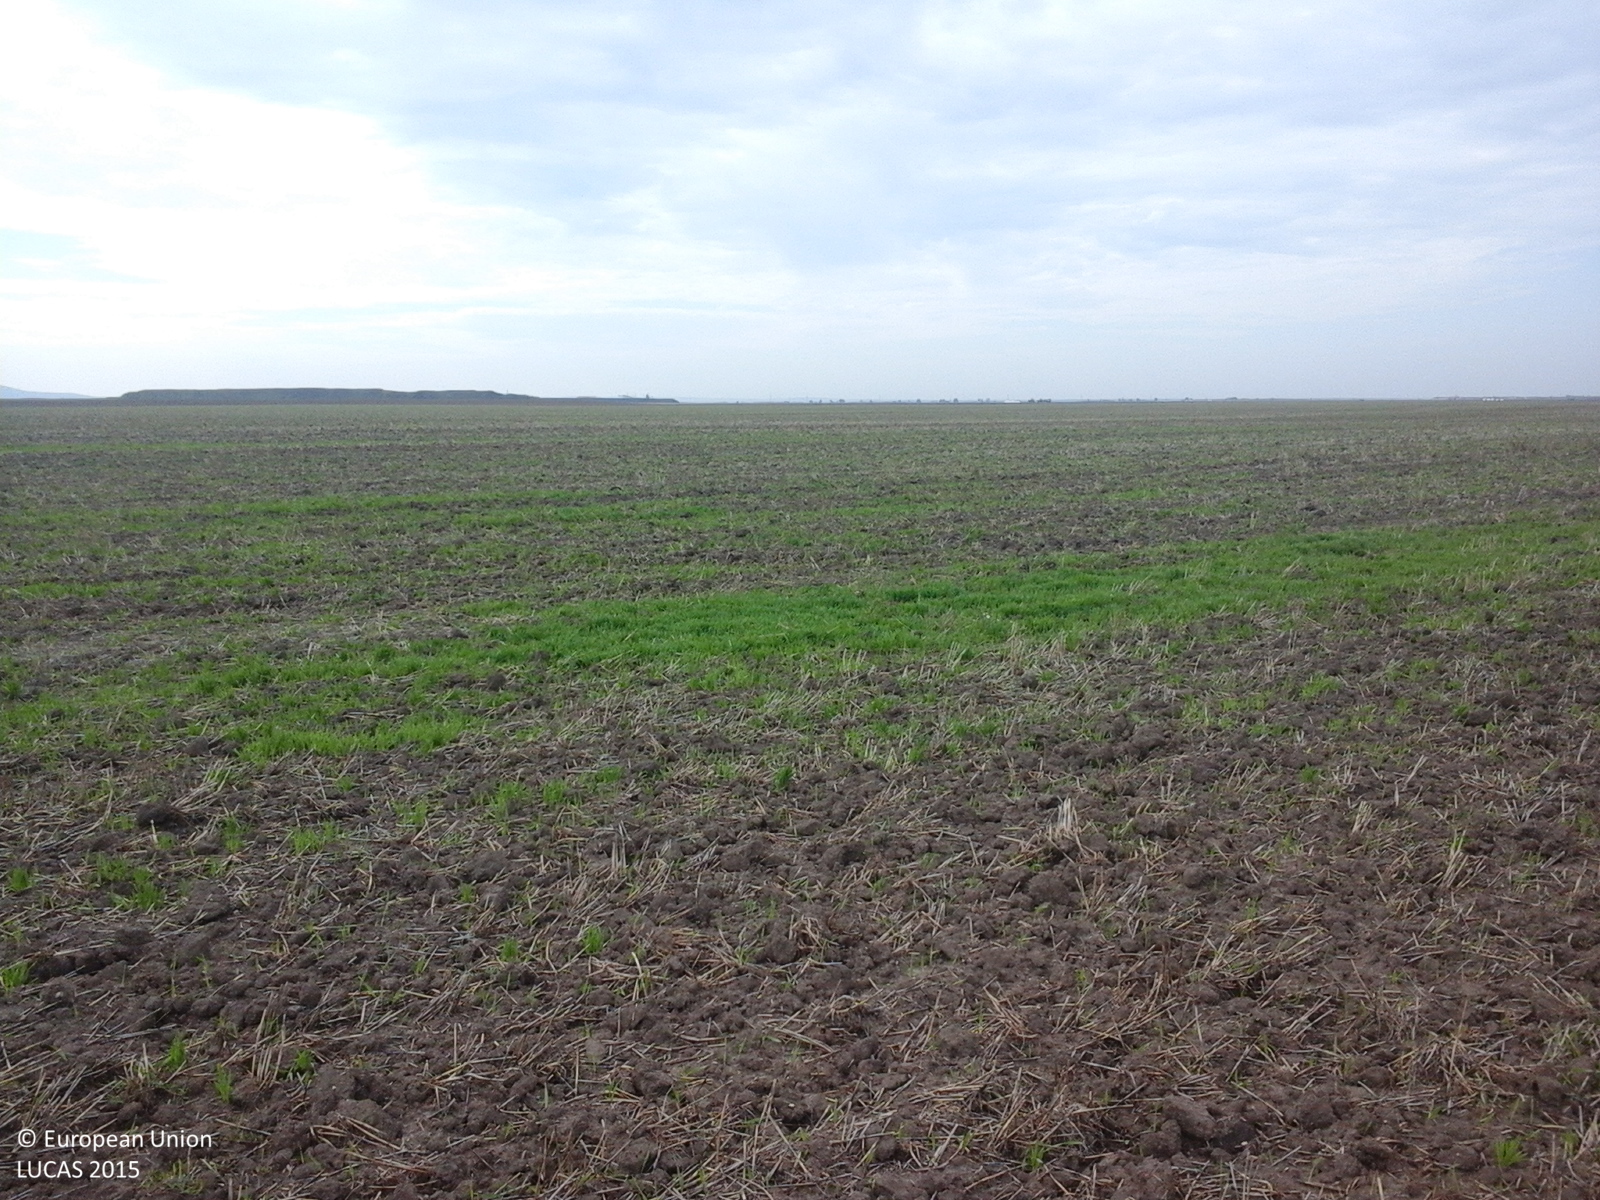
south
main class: Cropland
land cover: Common wheat
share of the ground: < 10 %
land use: Agriculture (excluding fallow land and kitchen gardens)
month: August
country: RO
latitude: 46.2570
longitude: 21.4912
